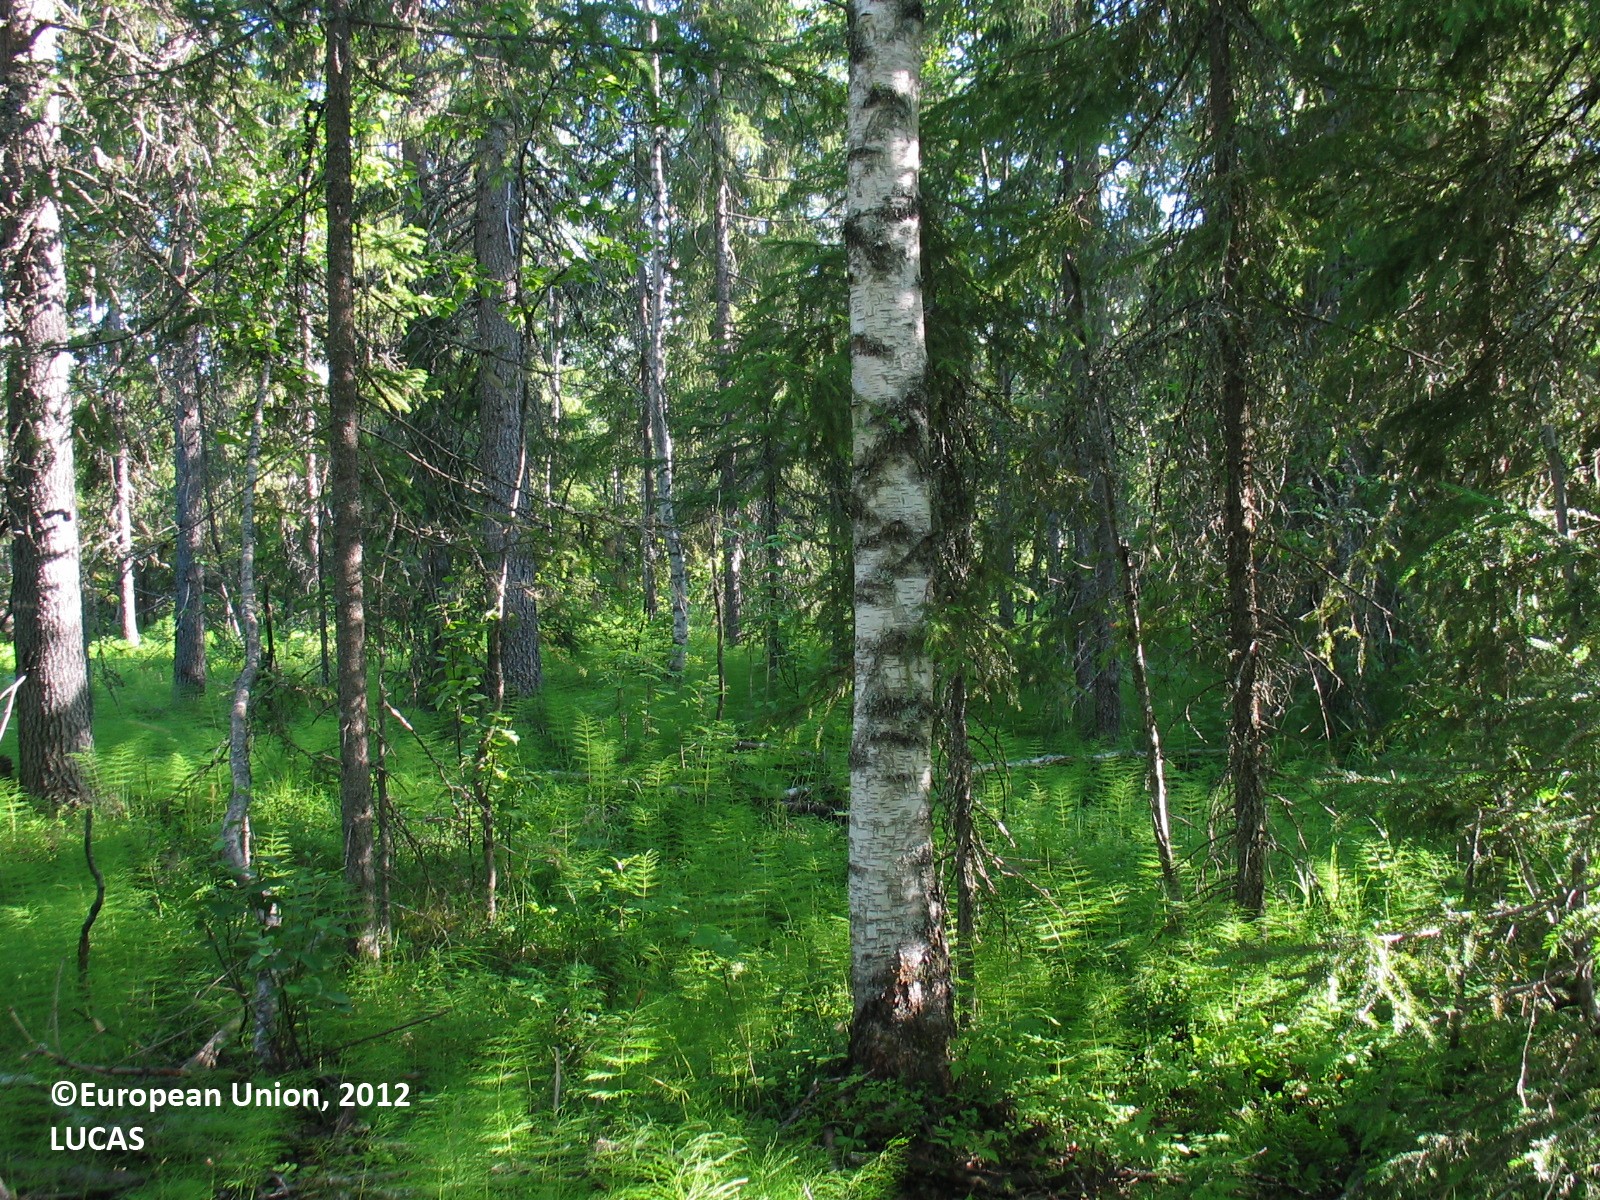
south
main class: Woodland
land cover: Other mixed woodland
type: boreal forest
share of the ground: 50 - 75 %
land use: Forestry
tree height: > 5 m
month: July
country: FI
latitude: 65.9546
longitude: 25.1746
